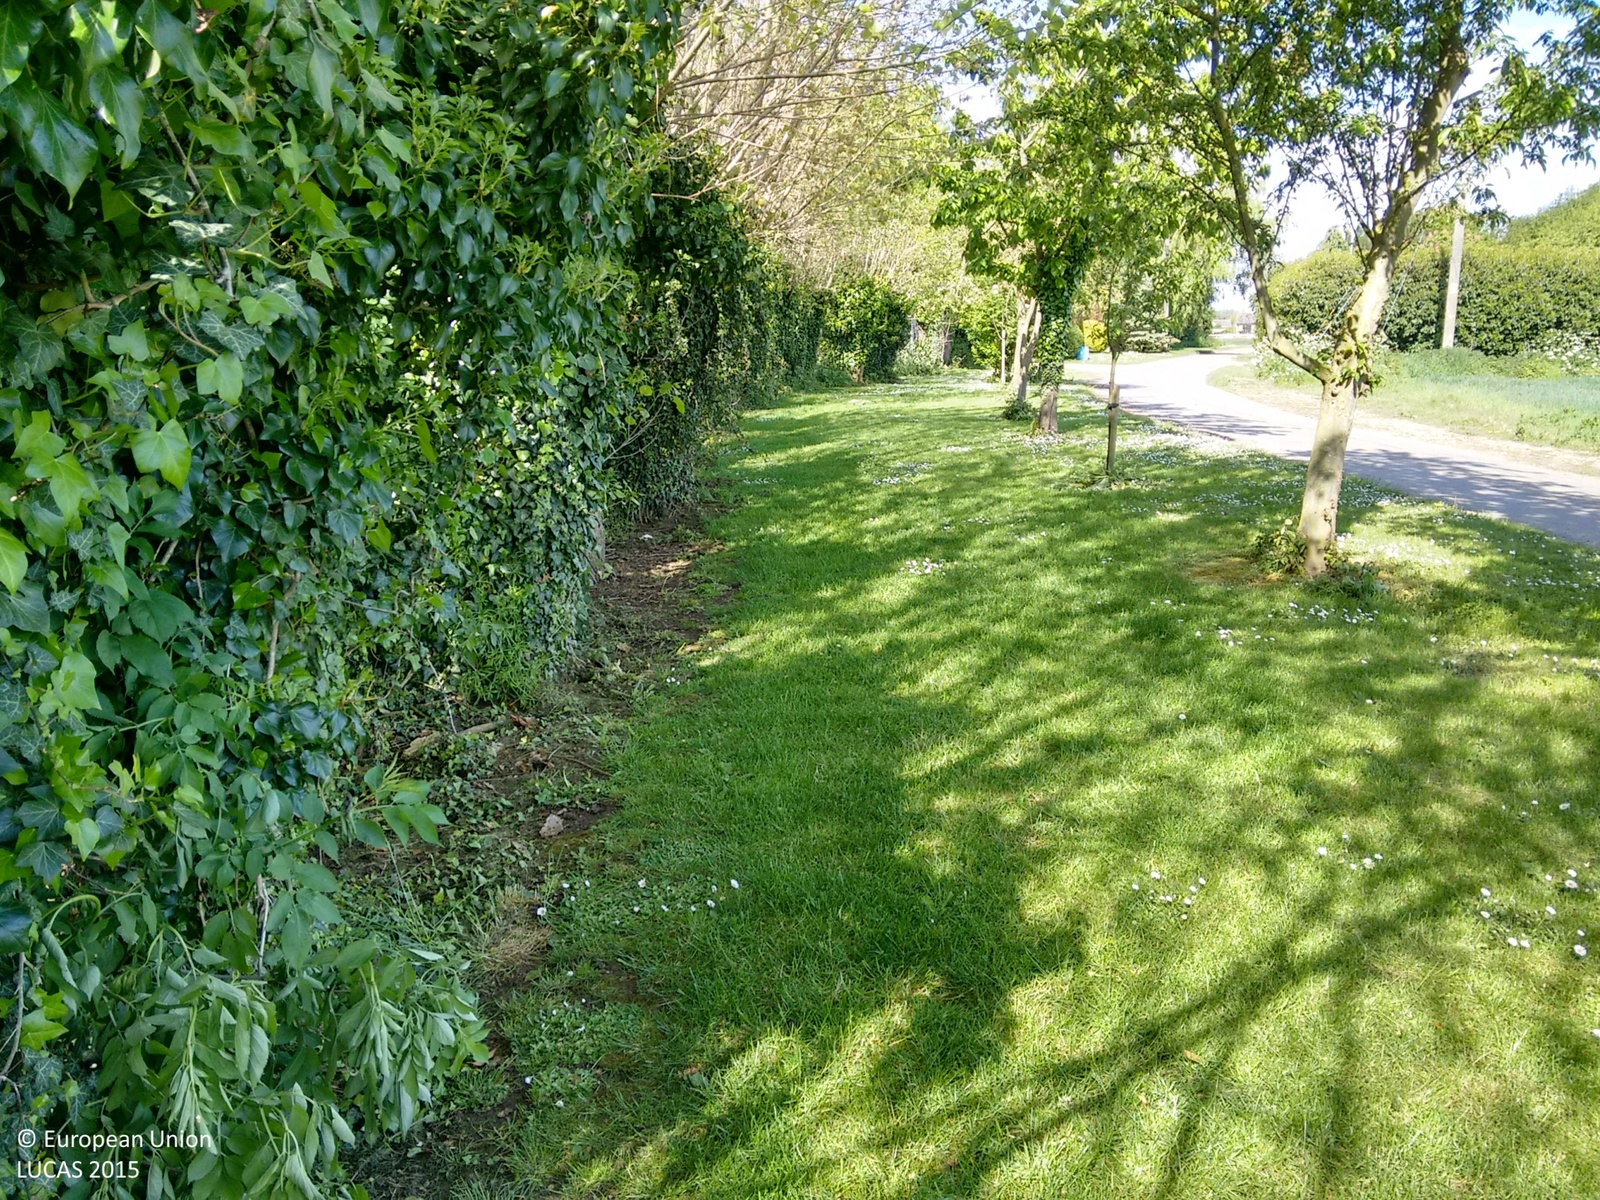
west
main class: Grassland
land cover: Grassland without tree/shrub cover
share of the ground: > 75 %
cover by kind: herbaceous plants 80 %, unconsolidated bare surface 20 %
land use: Logistics and storage
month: May
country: GB
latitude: 52.7843
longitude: -0.0408
